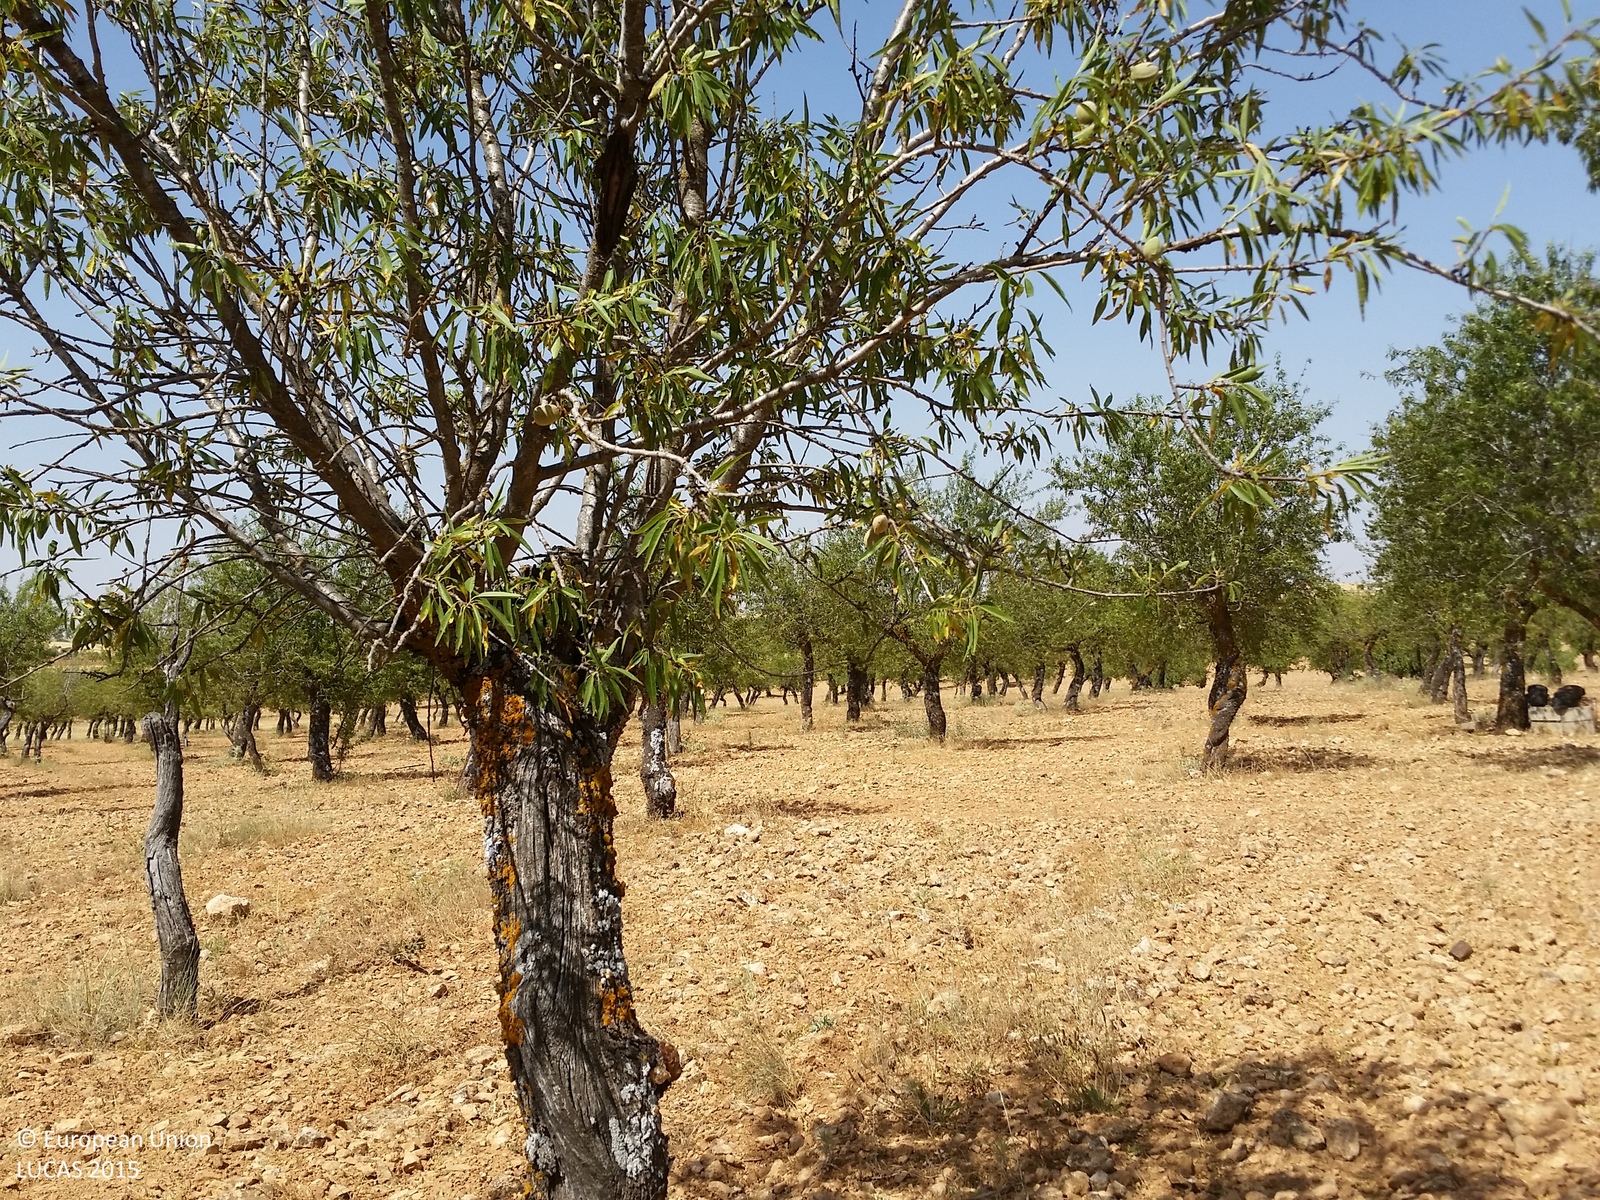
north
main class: Cropland
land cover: Nuts trees
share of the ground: 50 - 75 %
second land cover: Spontaneously vegetated surfaces
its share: 25 - 50 %
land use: Agriculture (excluding fallow land and kitchen gardens)
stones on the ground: 10 - 25 %
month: July
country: ES
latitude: 38.8955
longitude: -2.5142
